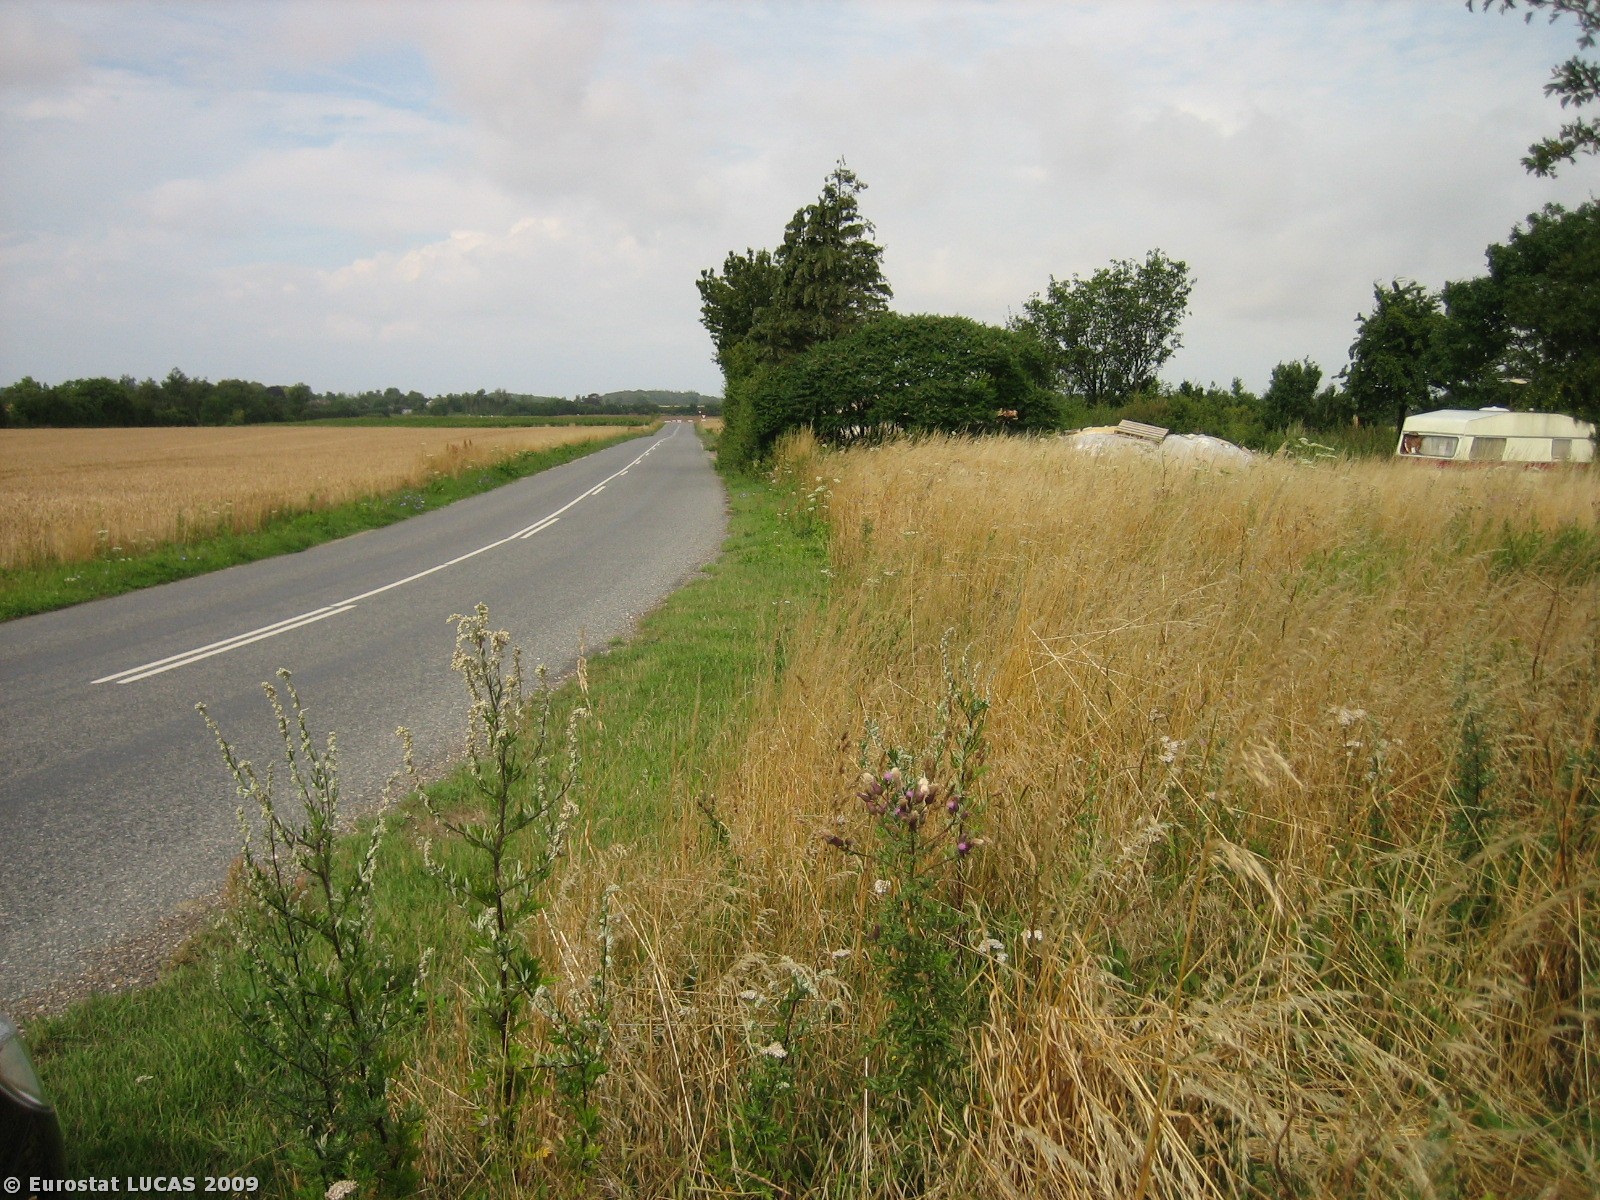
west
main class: Cropland
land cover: Common wheat
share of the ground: > 75 %
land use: Agriculture (excluding fallow land and kitchen gardens)
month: July
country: DK
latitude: 55.2171
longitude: 10.0471
